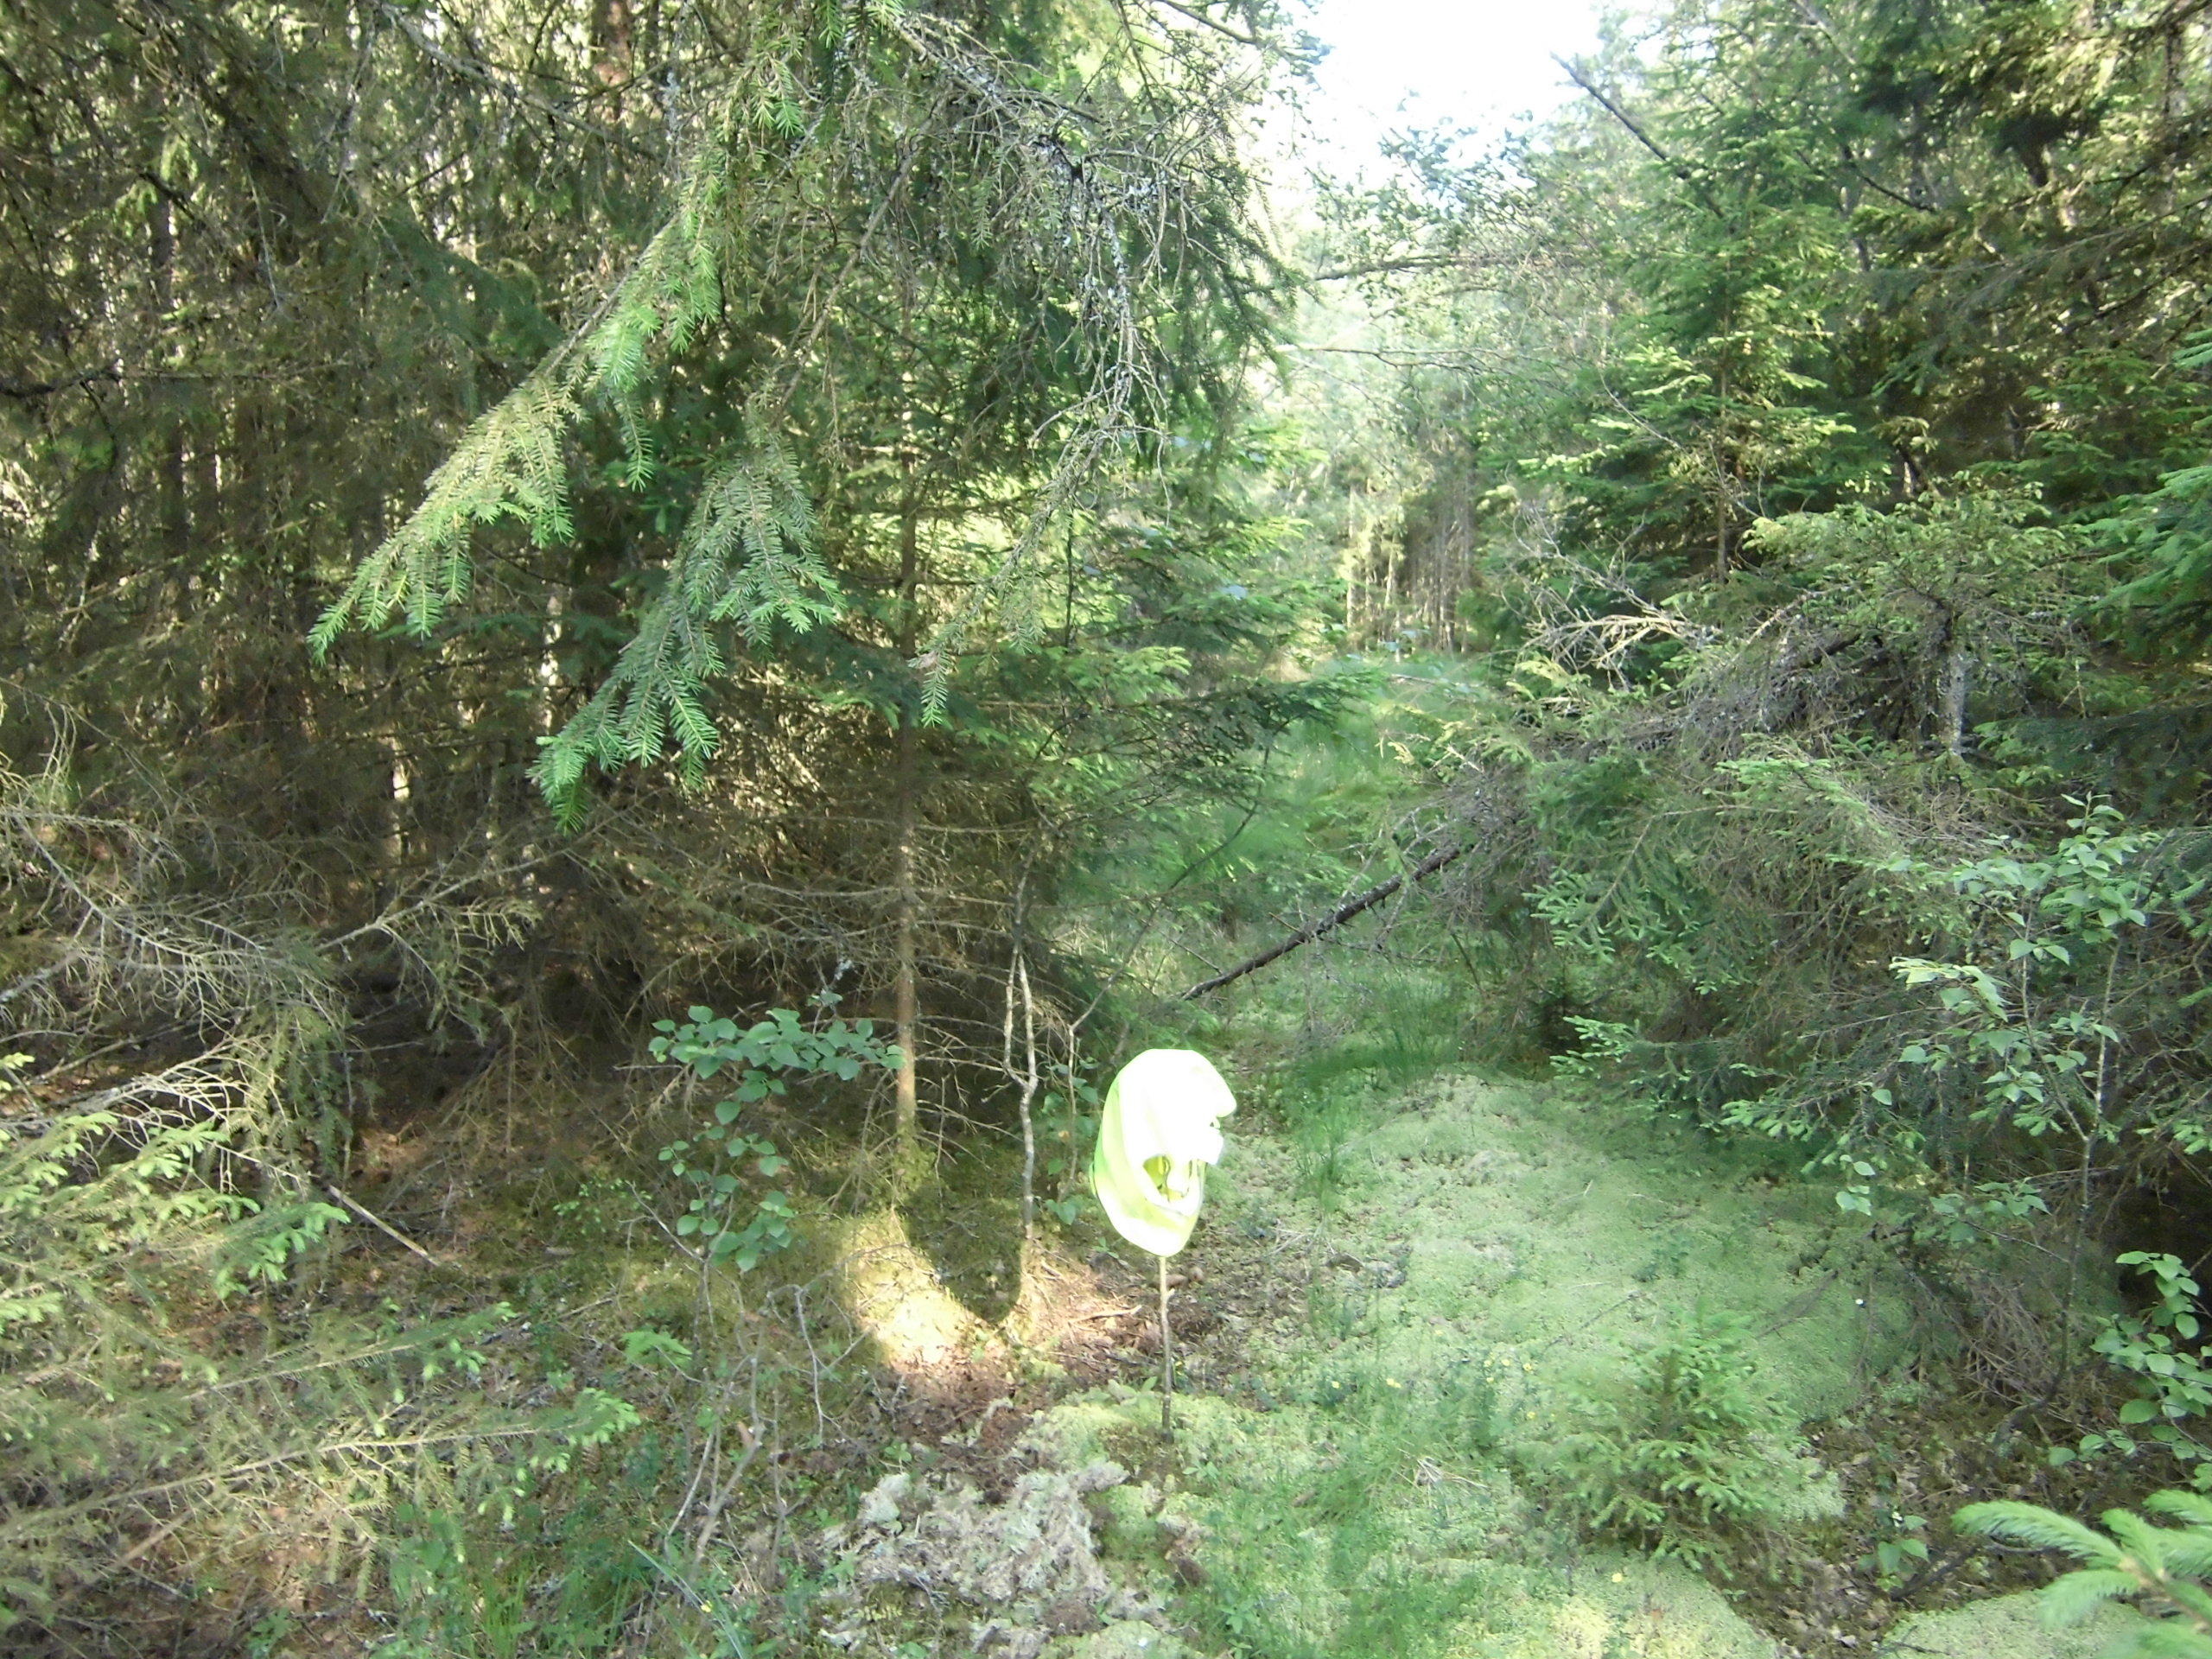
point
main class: Woodland
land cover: Spruce dominated coniferous woodland
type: boreal forest
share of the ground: 50 - 75 %
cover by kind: coniferous forest trees 55 %, herbaceous plants 20 %, broadleaved forest trees 10 %, lichens and mosses 10 %, shrubs 5 %
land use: Forestry
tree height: > 5 m
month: July
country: SE
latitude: 57.3805
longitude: 14.7032
